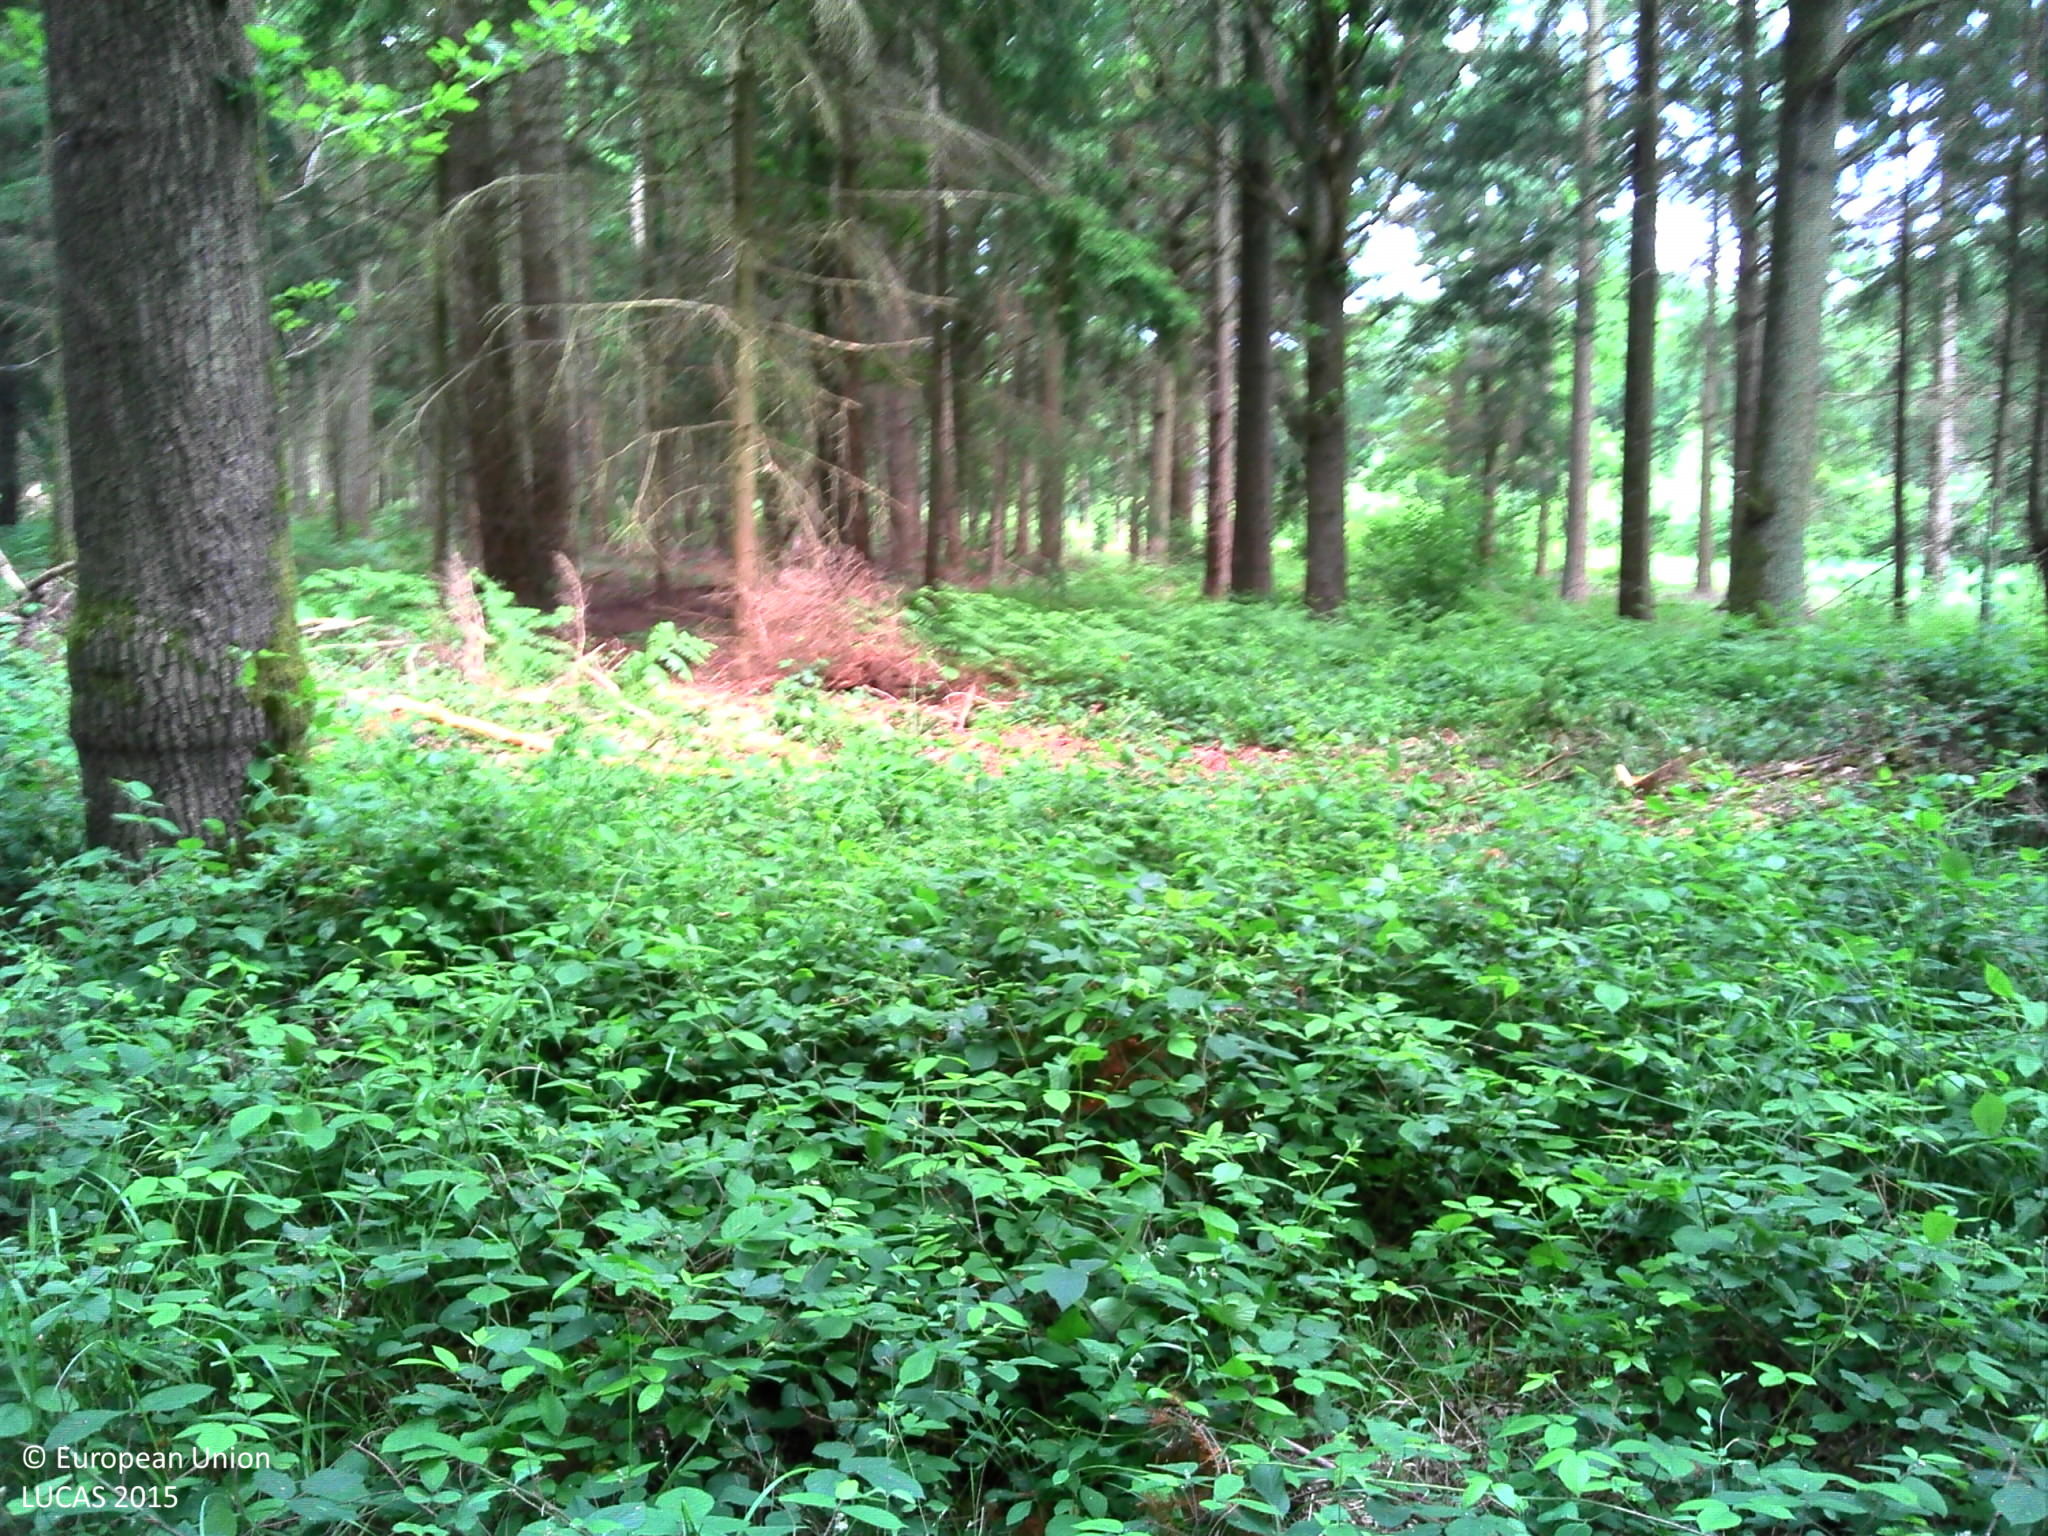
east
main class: Woodland
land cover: Pine dominated mixed woodland
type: exotic forest
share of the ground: > 75 %
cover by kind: coniferous forest trees 60 %, broadleaved forest trees 25 %, lichens and mosses 10 %, herbaceous plants 5 %
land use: Forestry
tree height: > 5 m
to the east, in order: Pine dominated mixed woodland; Shruby margins; Ditches and canals; Grass margins; Tracks; Grass margins; Ditches and canals; Spontaneously vegetated surfaces; Broadleaved woodland; Spontaneously vegetated surfaces; Broadleaved woodland
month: June
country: FR
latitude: 50.7557
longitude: 2.3174
